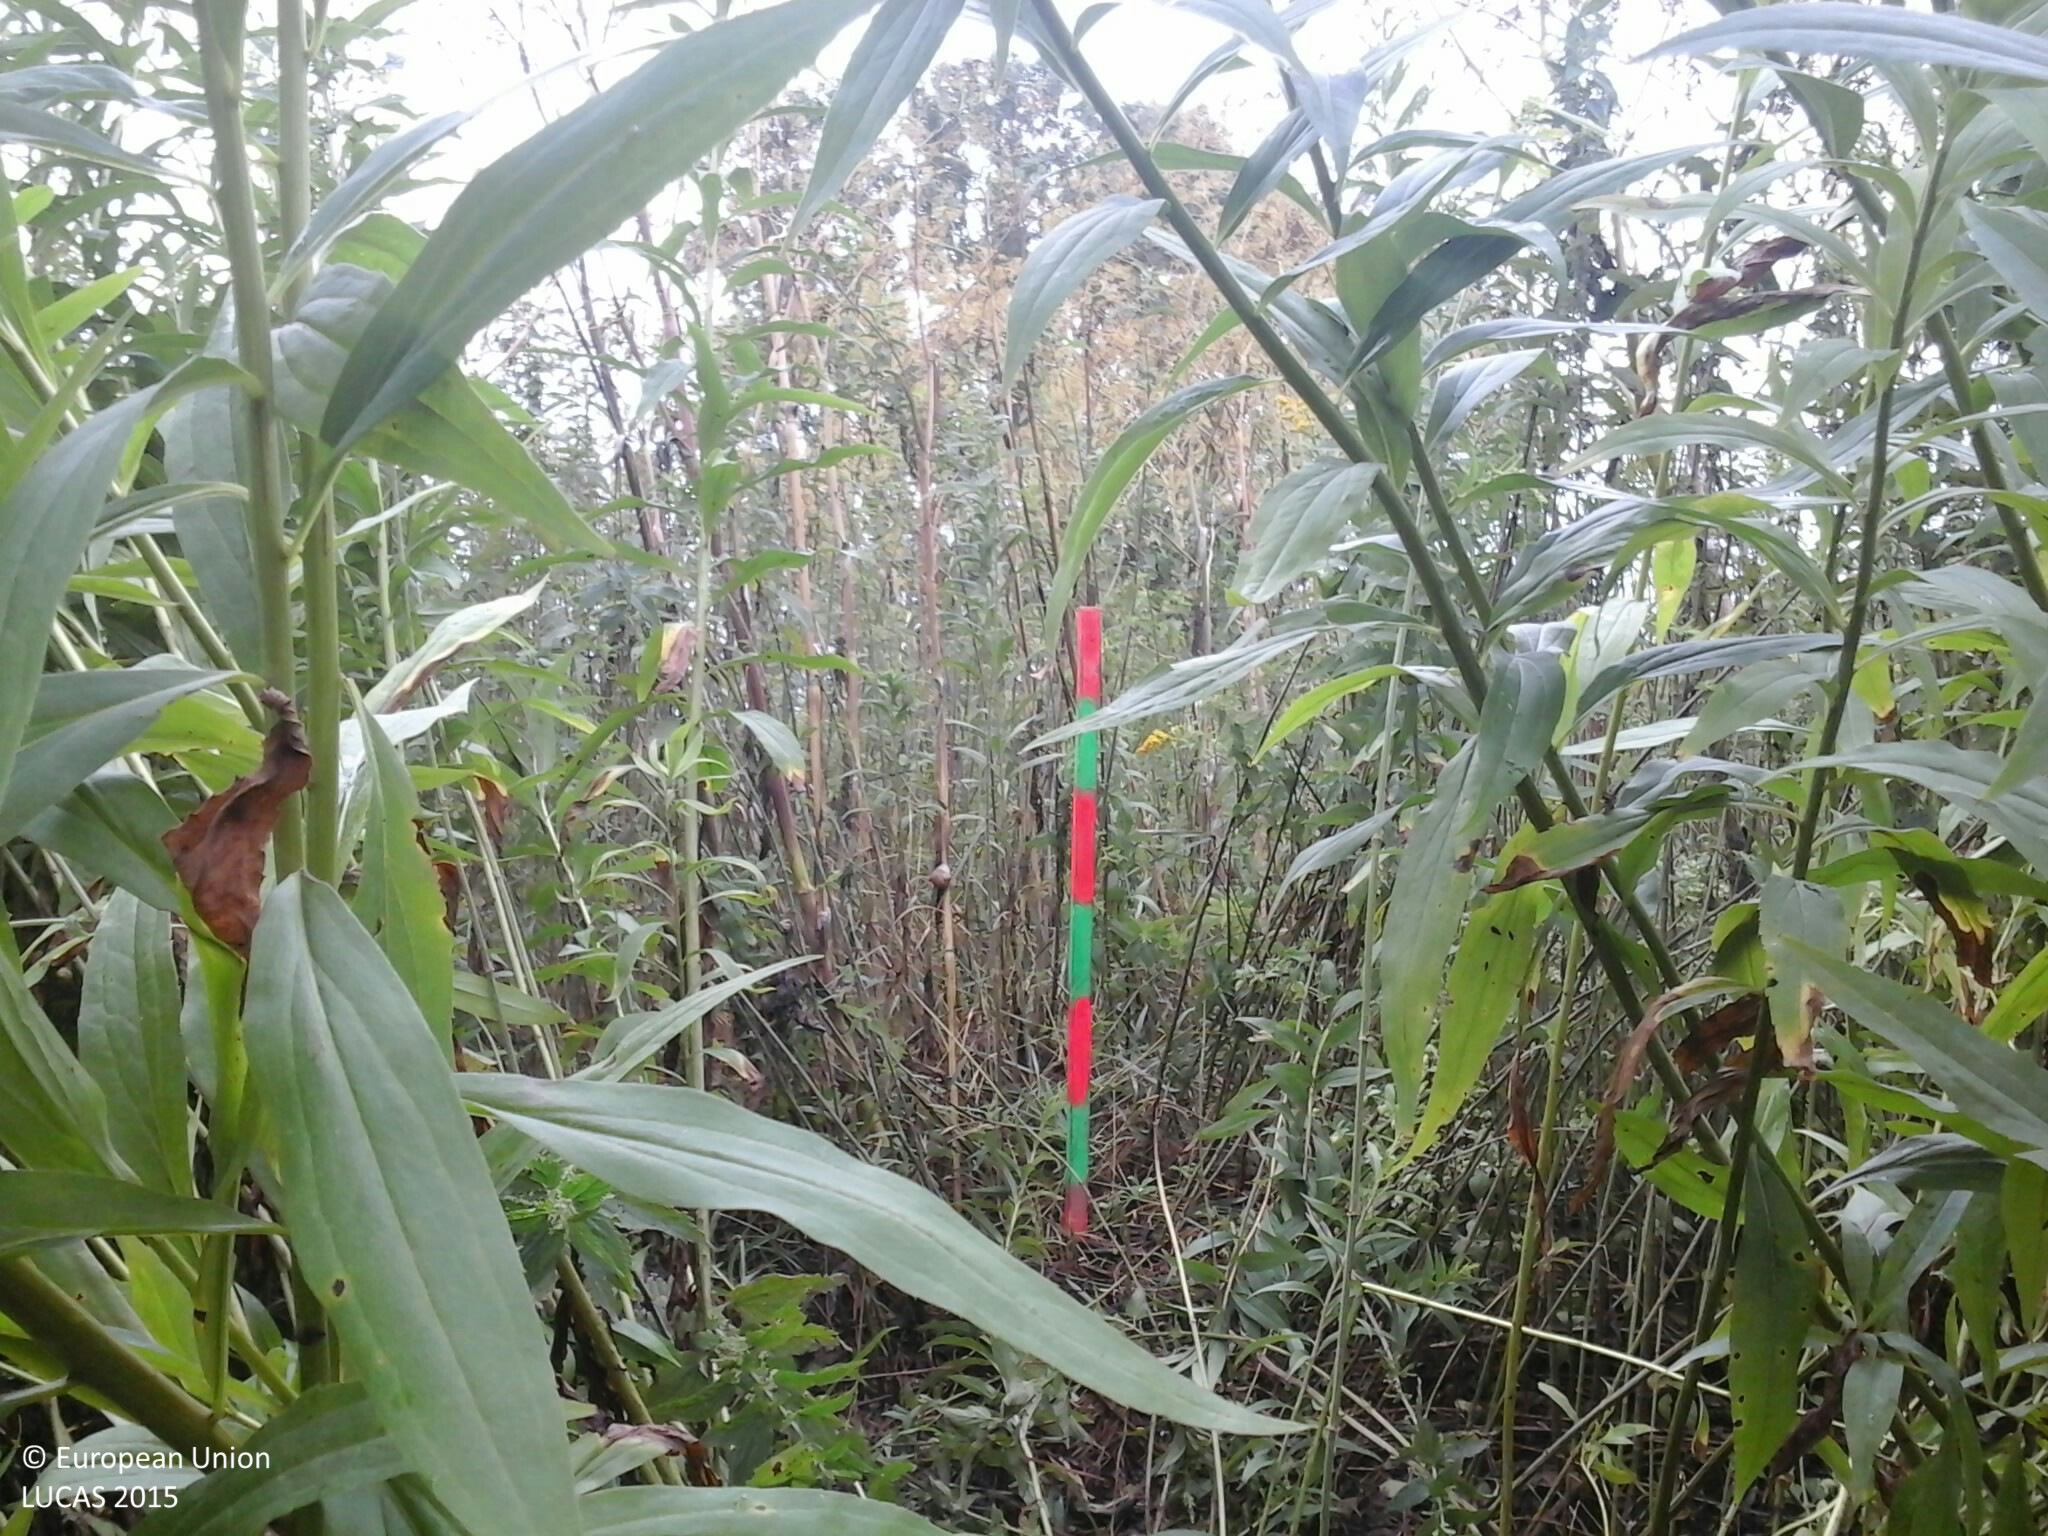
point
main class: Grassland
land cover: Spontaneously vegetated surfaces
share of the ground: > 75 %
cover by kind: herbaceous plants 100 %
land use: Semi-natural and natural areas not in use
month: July
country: HU
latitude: 46.5607
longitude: 17.7156
